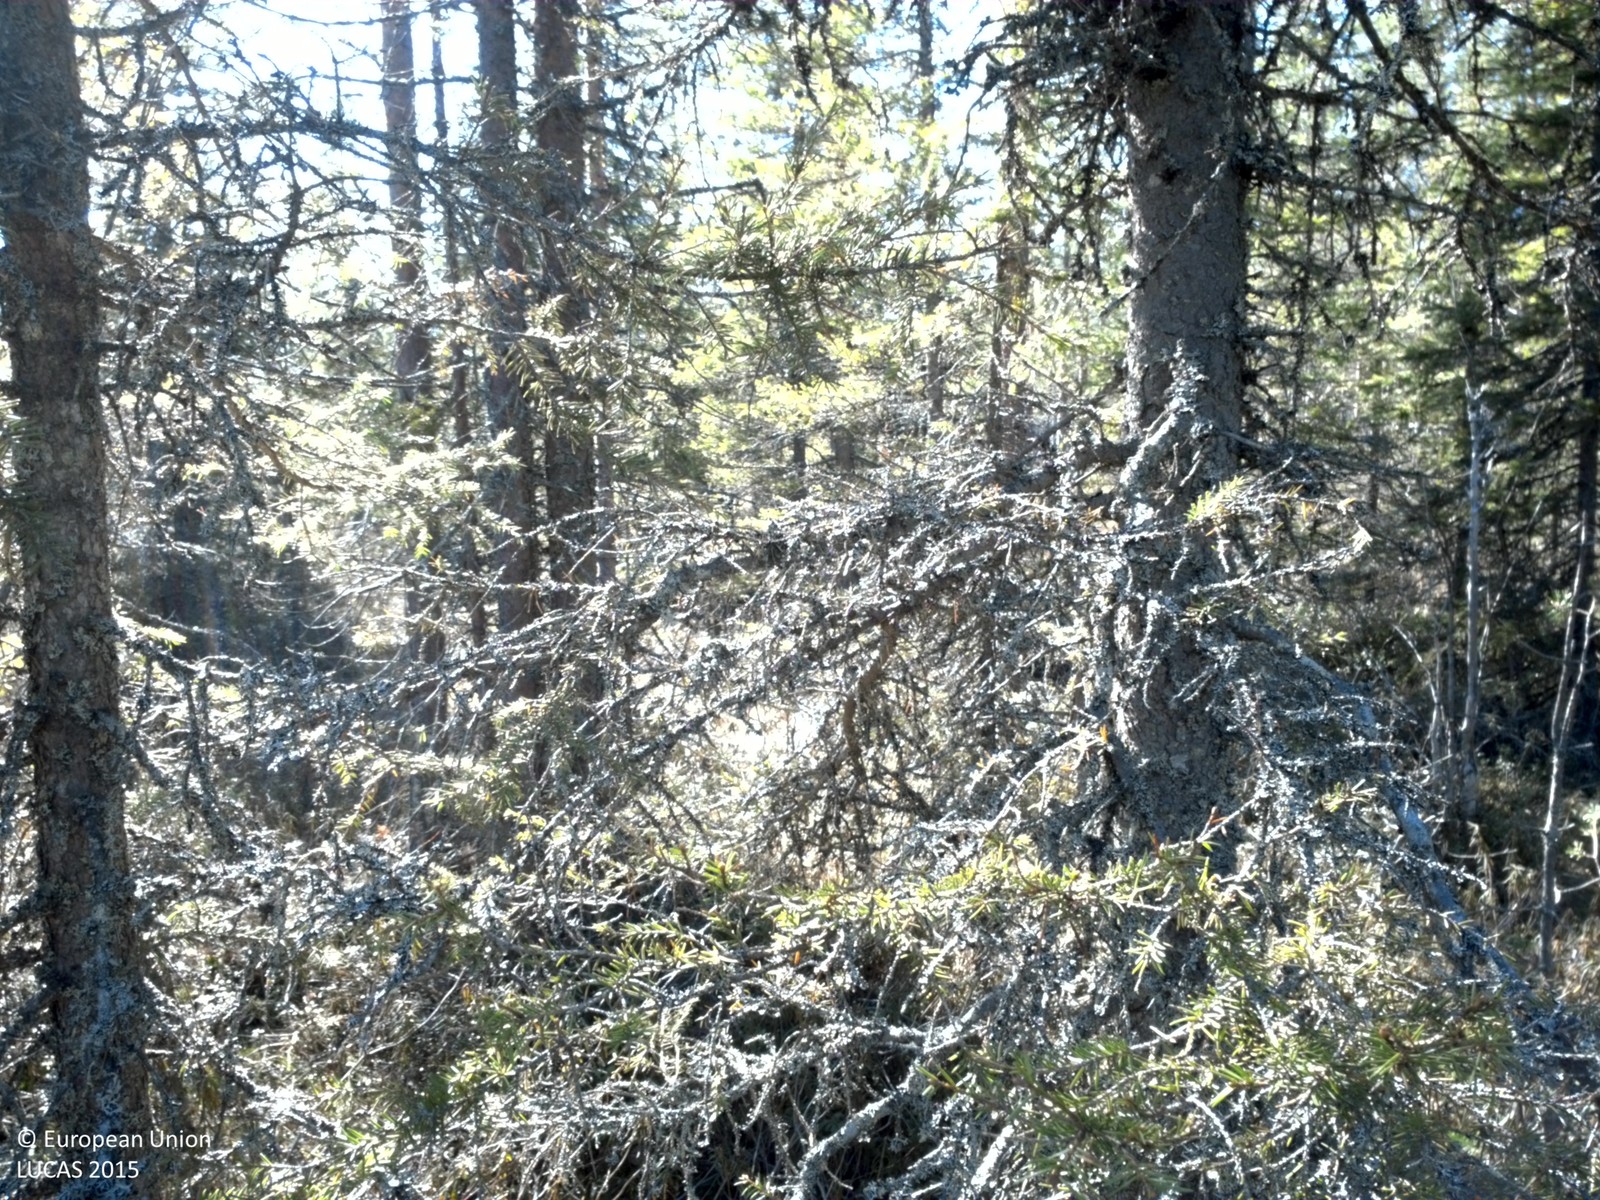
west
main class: Woodland
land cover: Other coniferous woodland
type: boreal forest
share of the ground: > 75 %
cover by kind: coniferous forest trees 75 %, shrubs 20 %, broadleaved forest trees 5 %
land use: Forestry
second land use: Community services
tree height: > 5 m
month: May
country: SE
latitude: 66.1866
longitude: 23.1005
